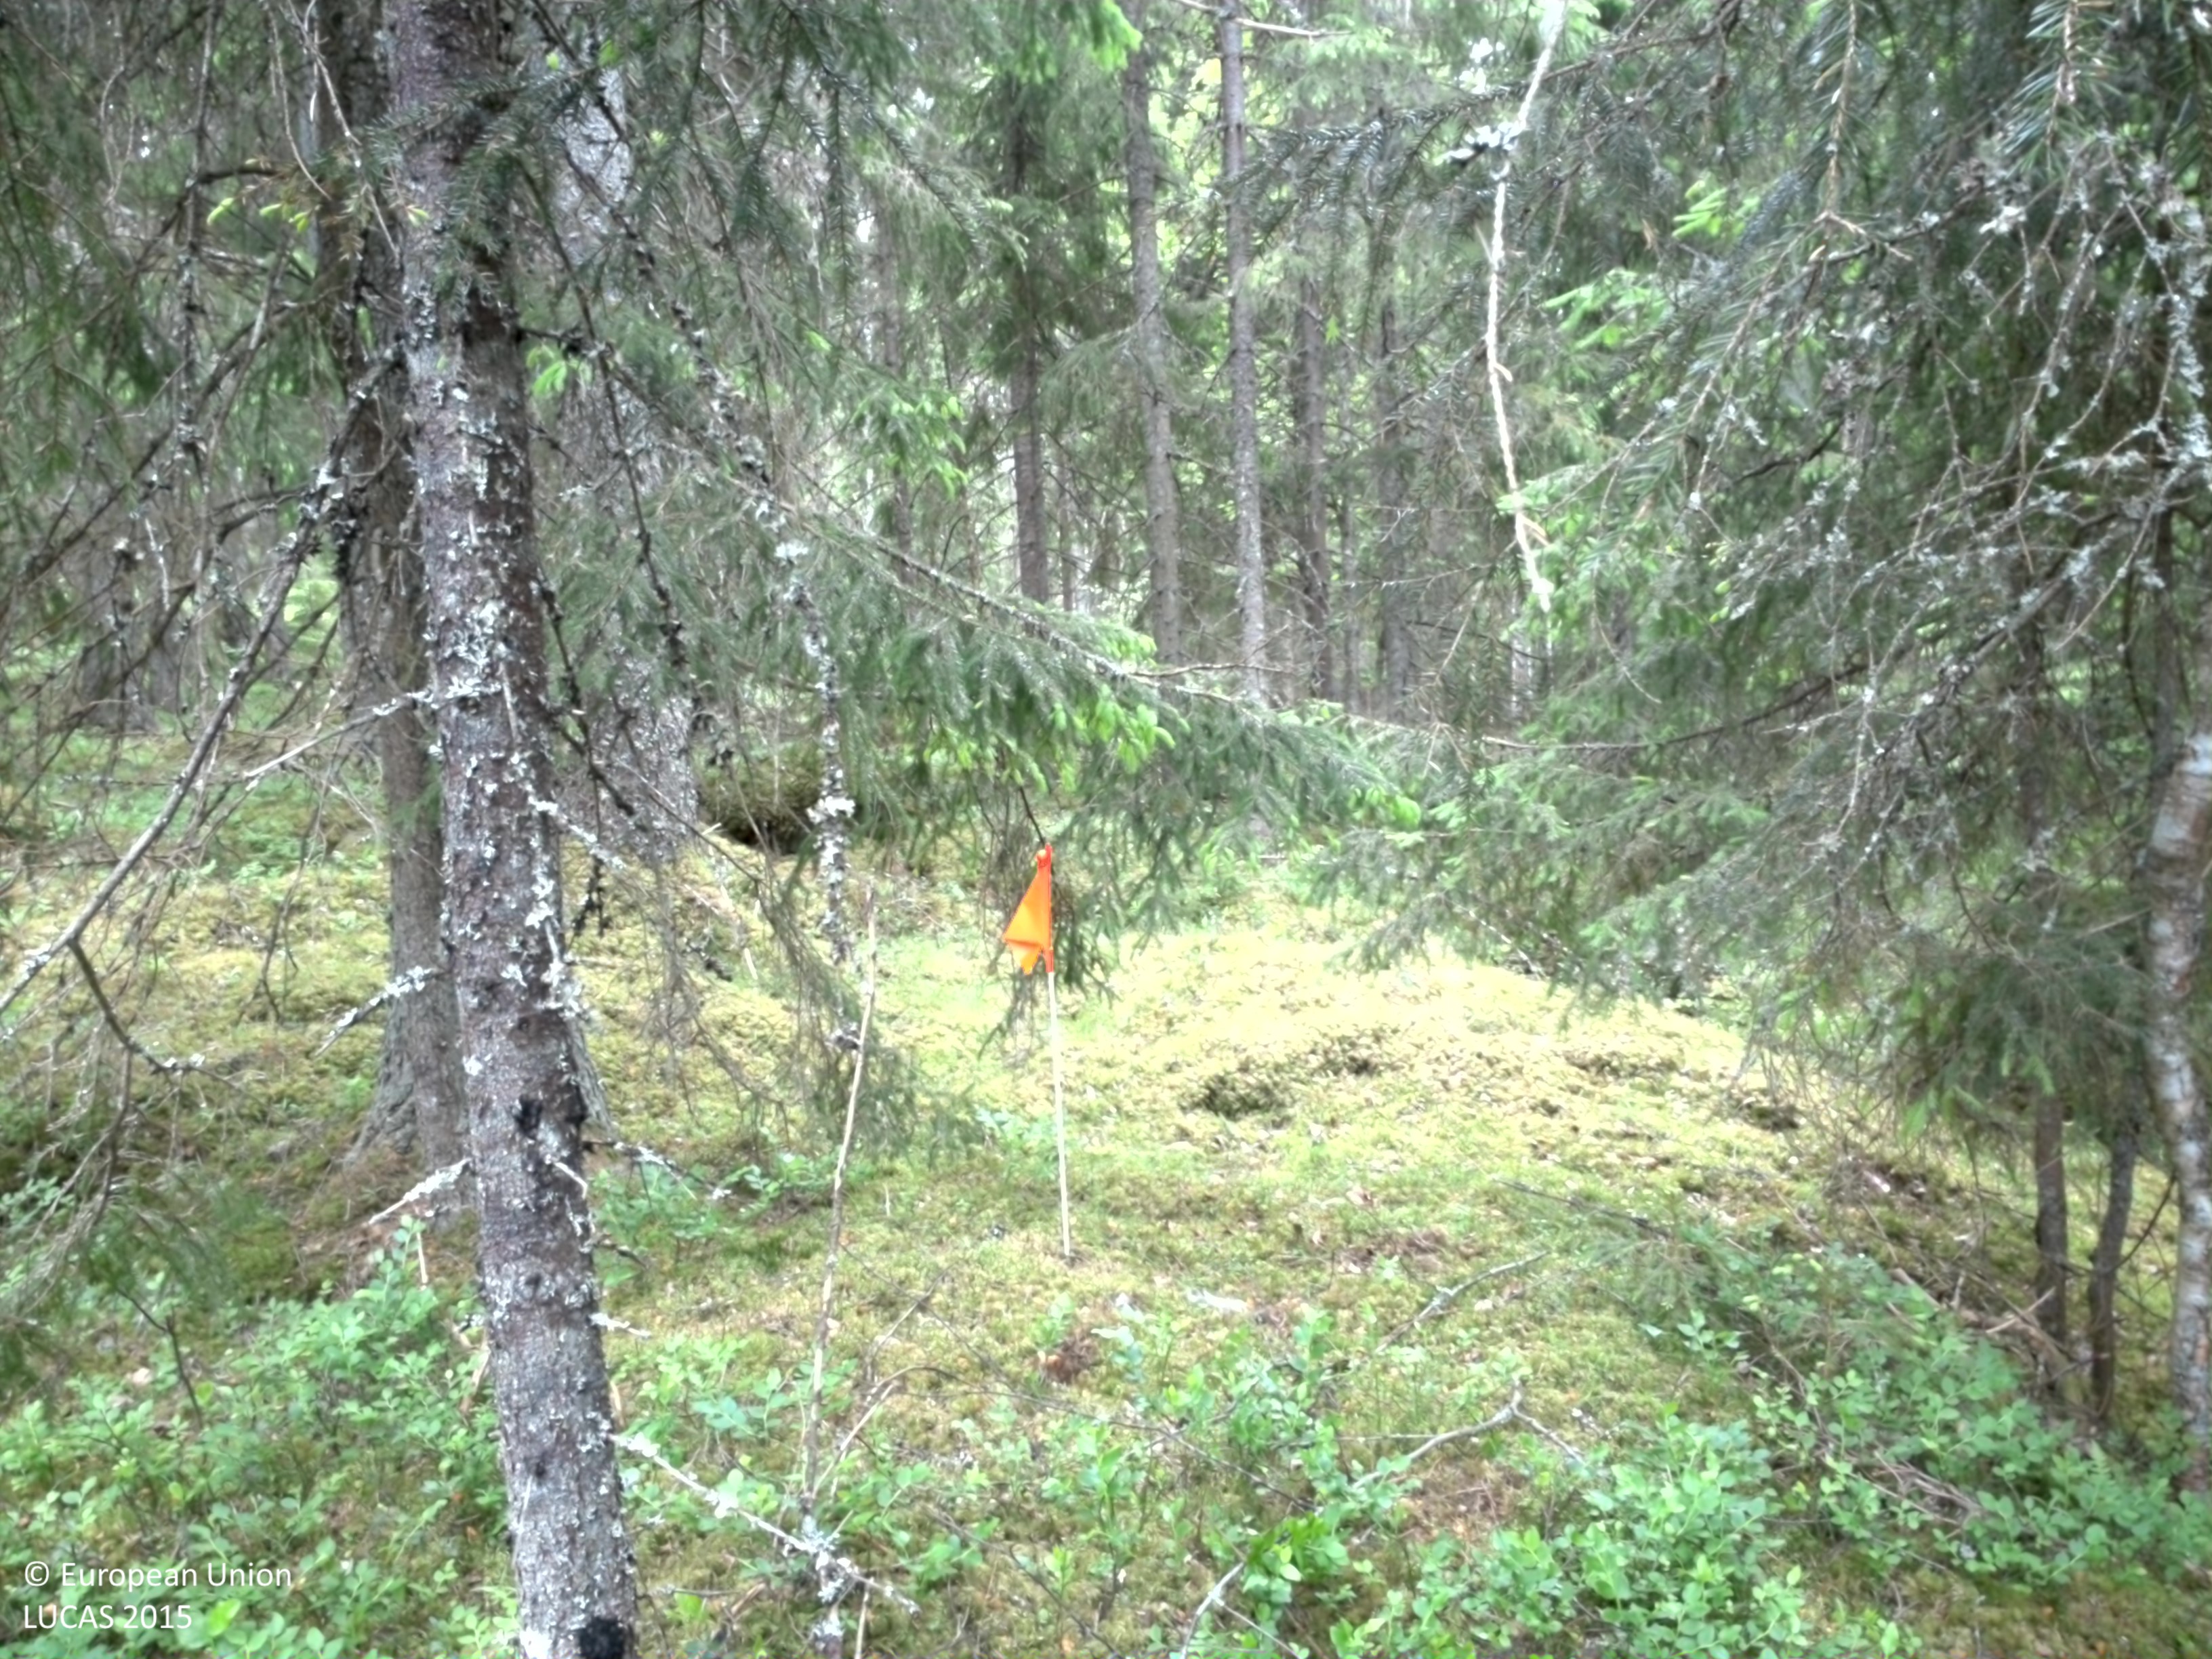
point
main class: Woodland
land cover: Spruce dominated mixed woodland
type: boreal forest
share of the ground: > 75 %
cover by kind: coniferous forest trees 55 %, broadleaved forest trees 25 %, shrubs 10 %, lichens and mosses 10 %
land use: Forestry
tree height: > 5 m
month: June
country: SE
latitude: 59.6137
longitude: 14.1914
